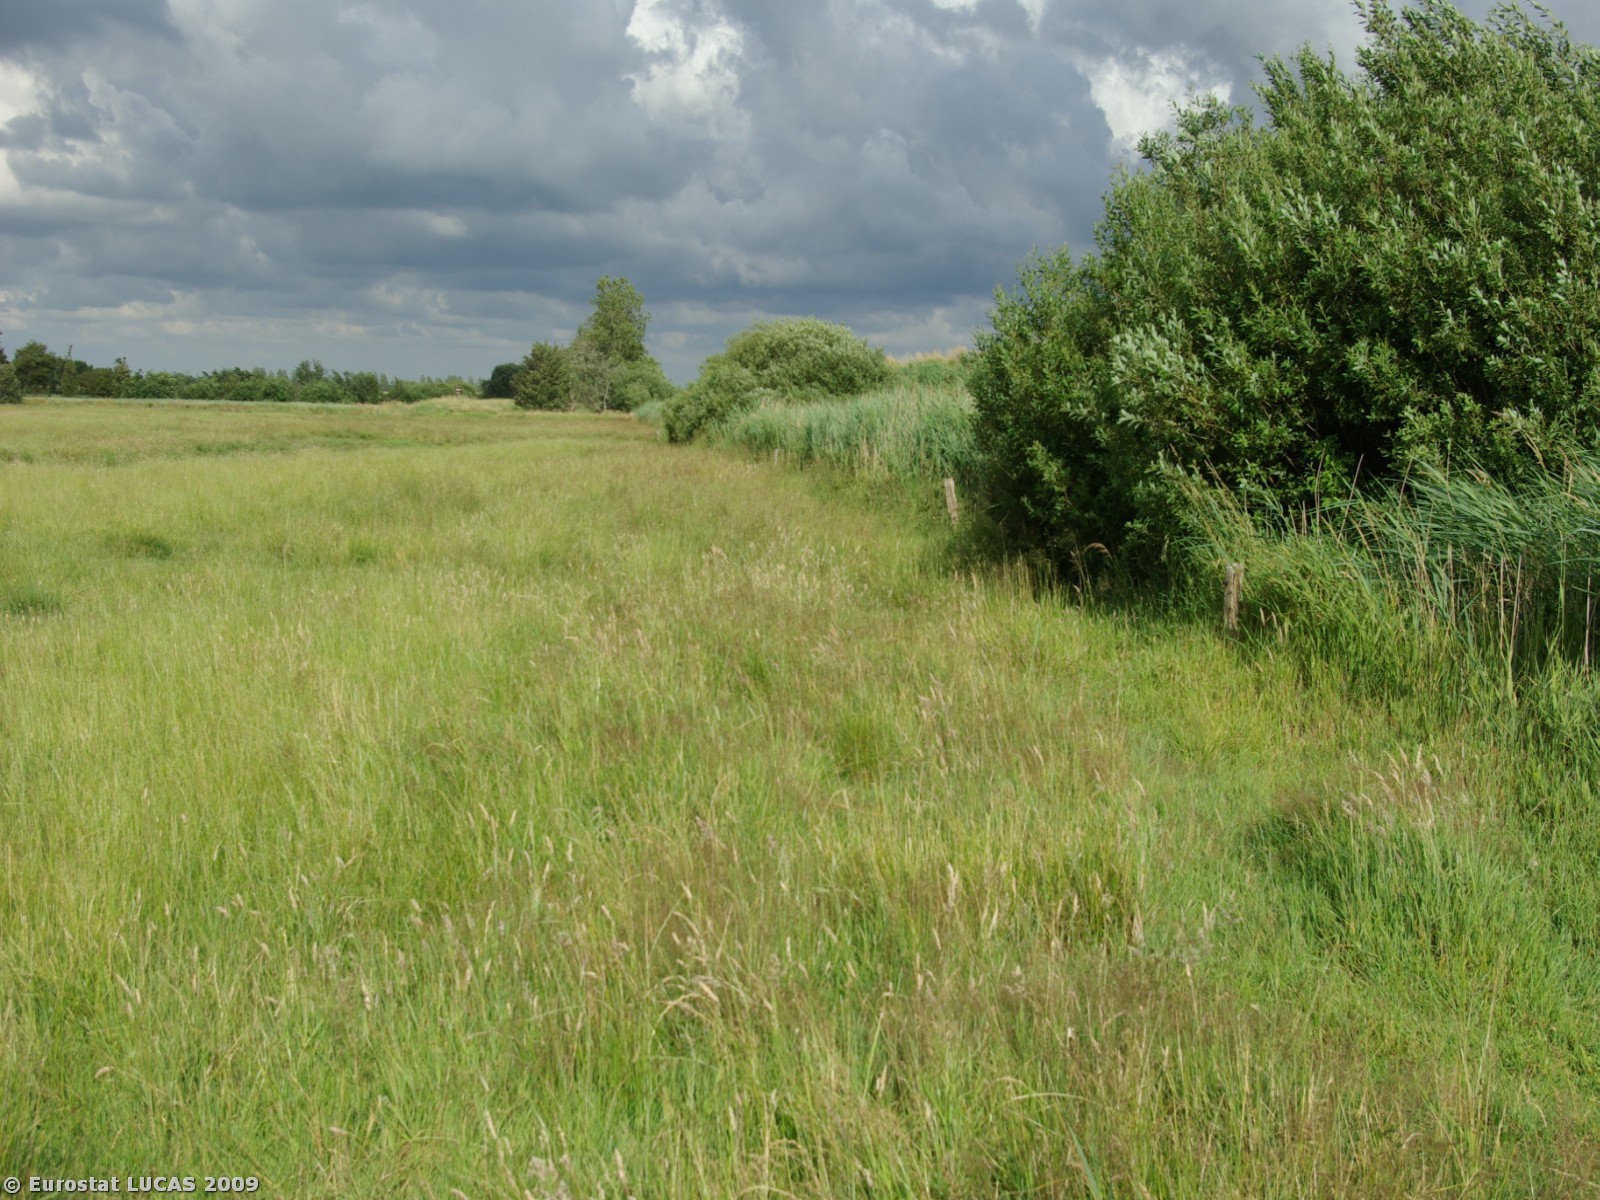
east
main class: Grassland
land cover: Grassland without tree/shrub cover
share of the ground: > 75 %
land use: Agriculture (excluding fallow land and kitchen gardens)
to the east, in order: Grassland without tree/shrub cover; Fences; Shruby margins; Ditches and canals; Spontaneously vegetated surfaces; Grassland without tree/shrub cover
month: July
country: DK
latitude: 54.9247
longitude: 8.8930
